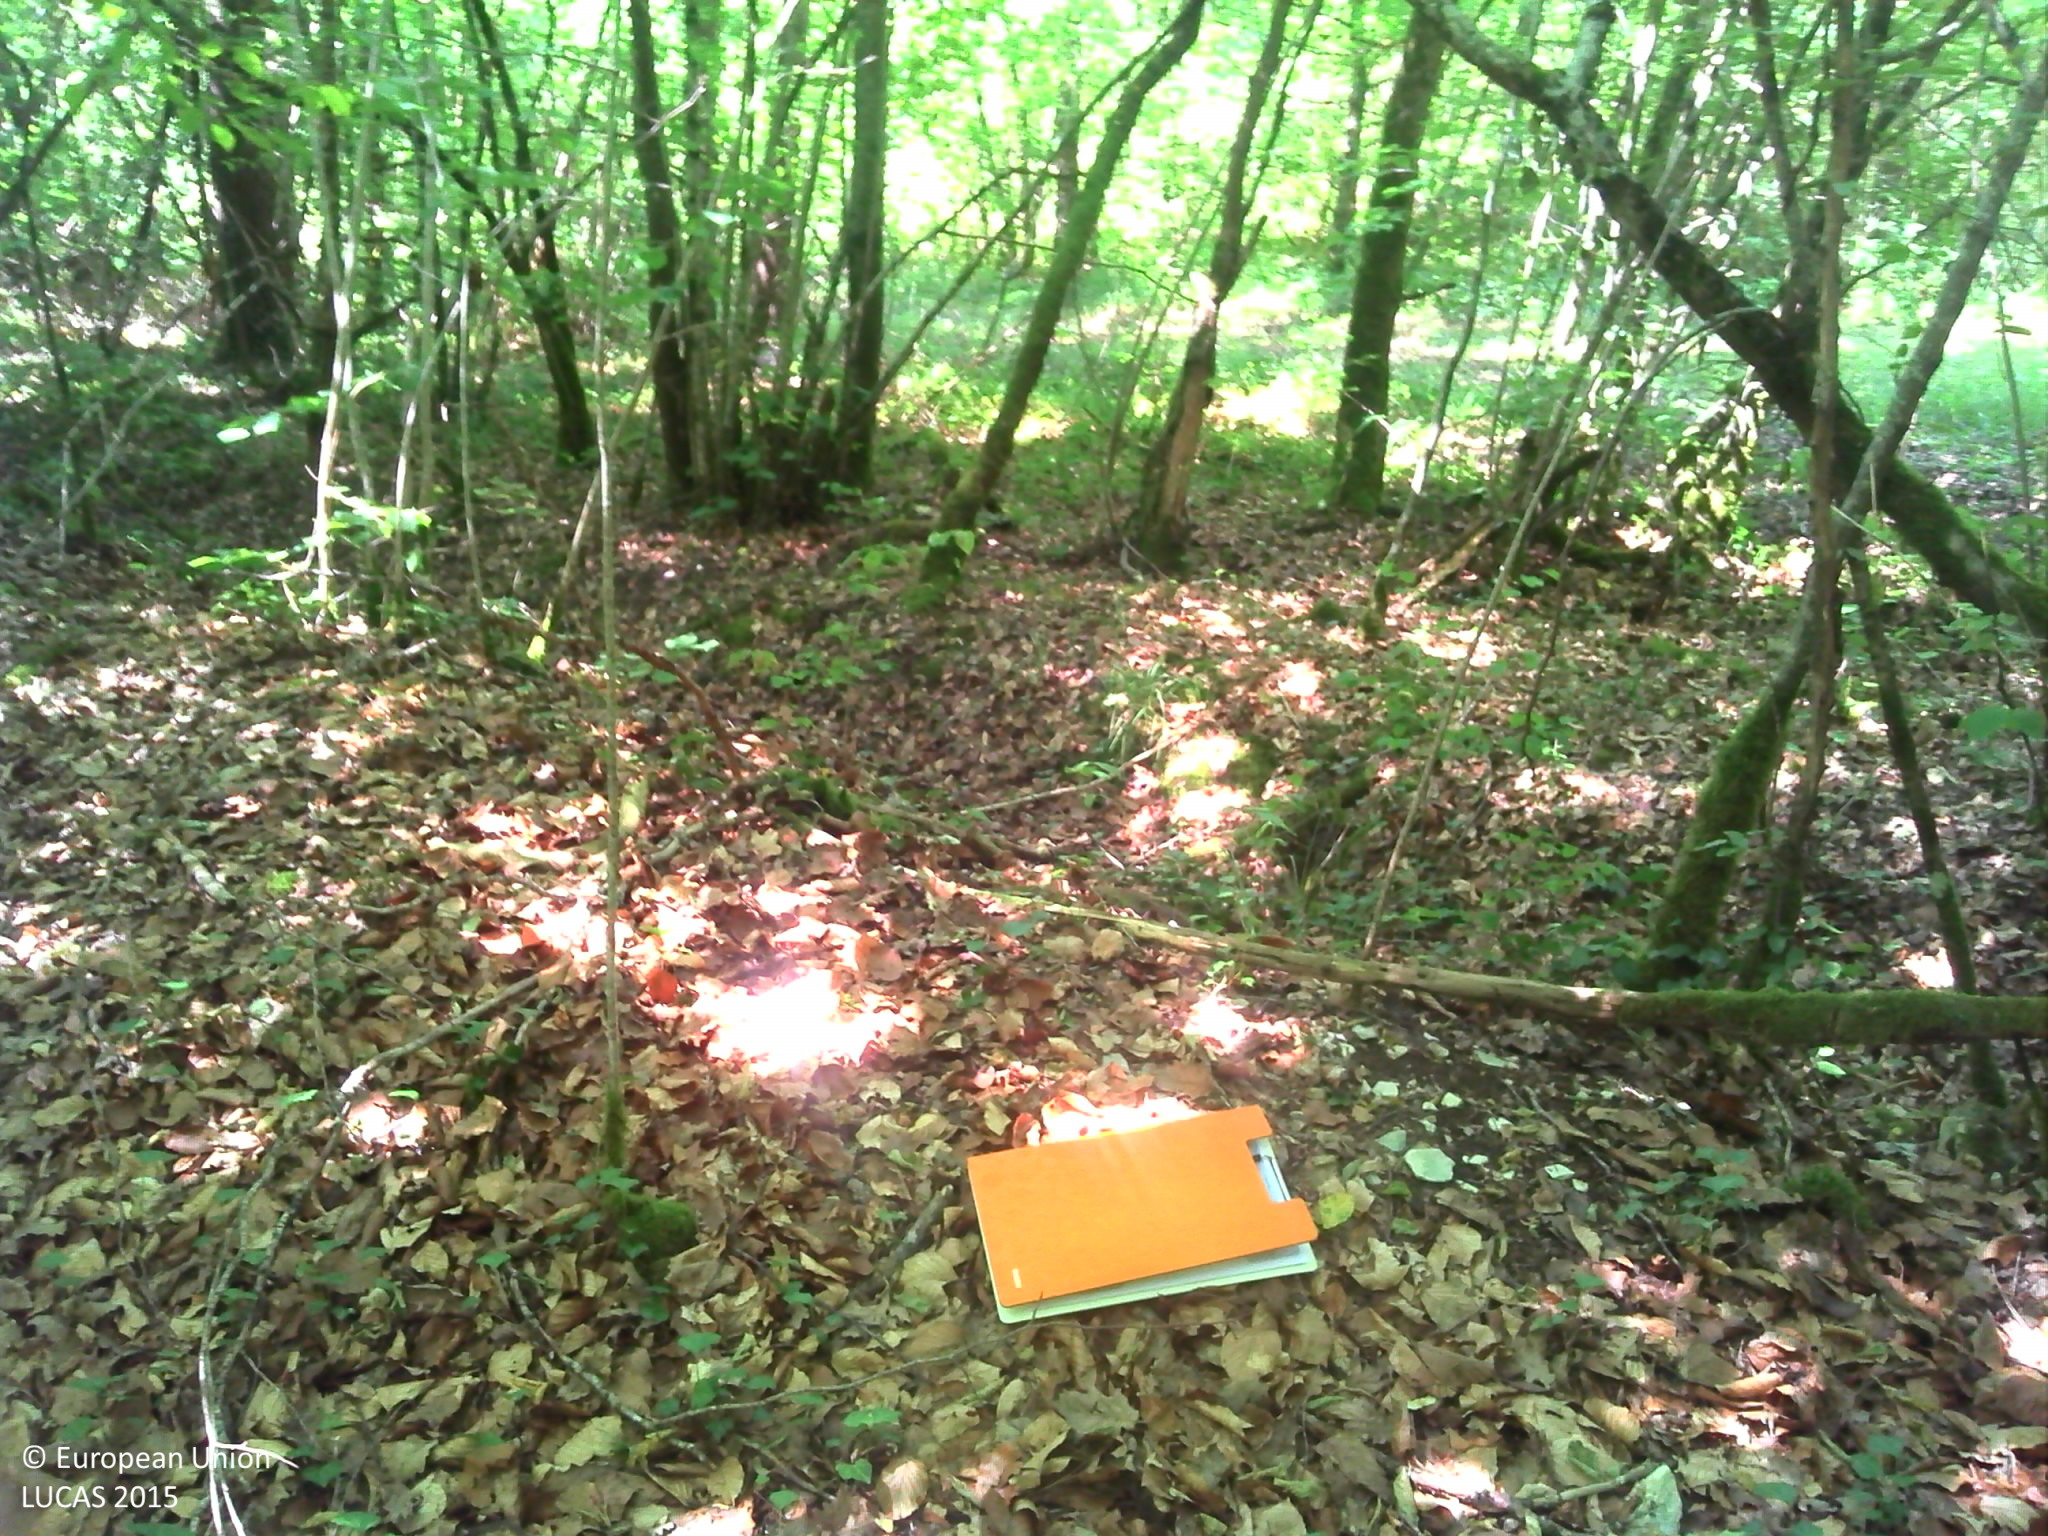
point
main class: Woodland
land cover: Broadleaved woodland
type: acidophilous oak and oak-birch forest
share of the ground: > 75 %
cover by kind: broadleaved forest trees 80 %, herbaceous plants 10 %, lichens and mosses 10 %
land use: Forestry
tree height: > 5 m
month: July
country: FR
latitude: 48.0304
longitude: 4.8357
